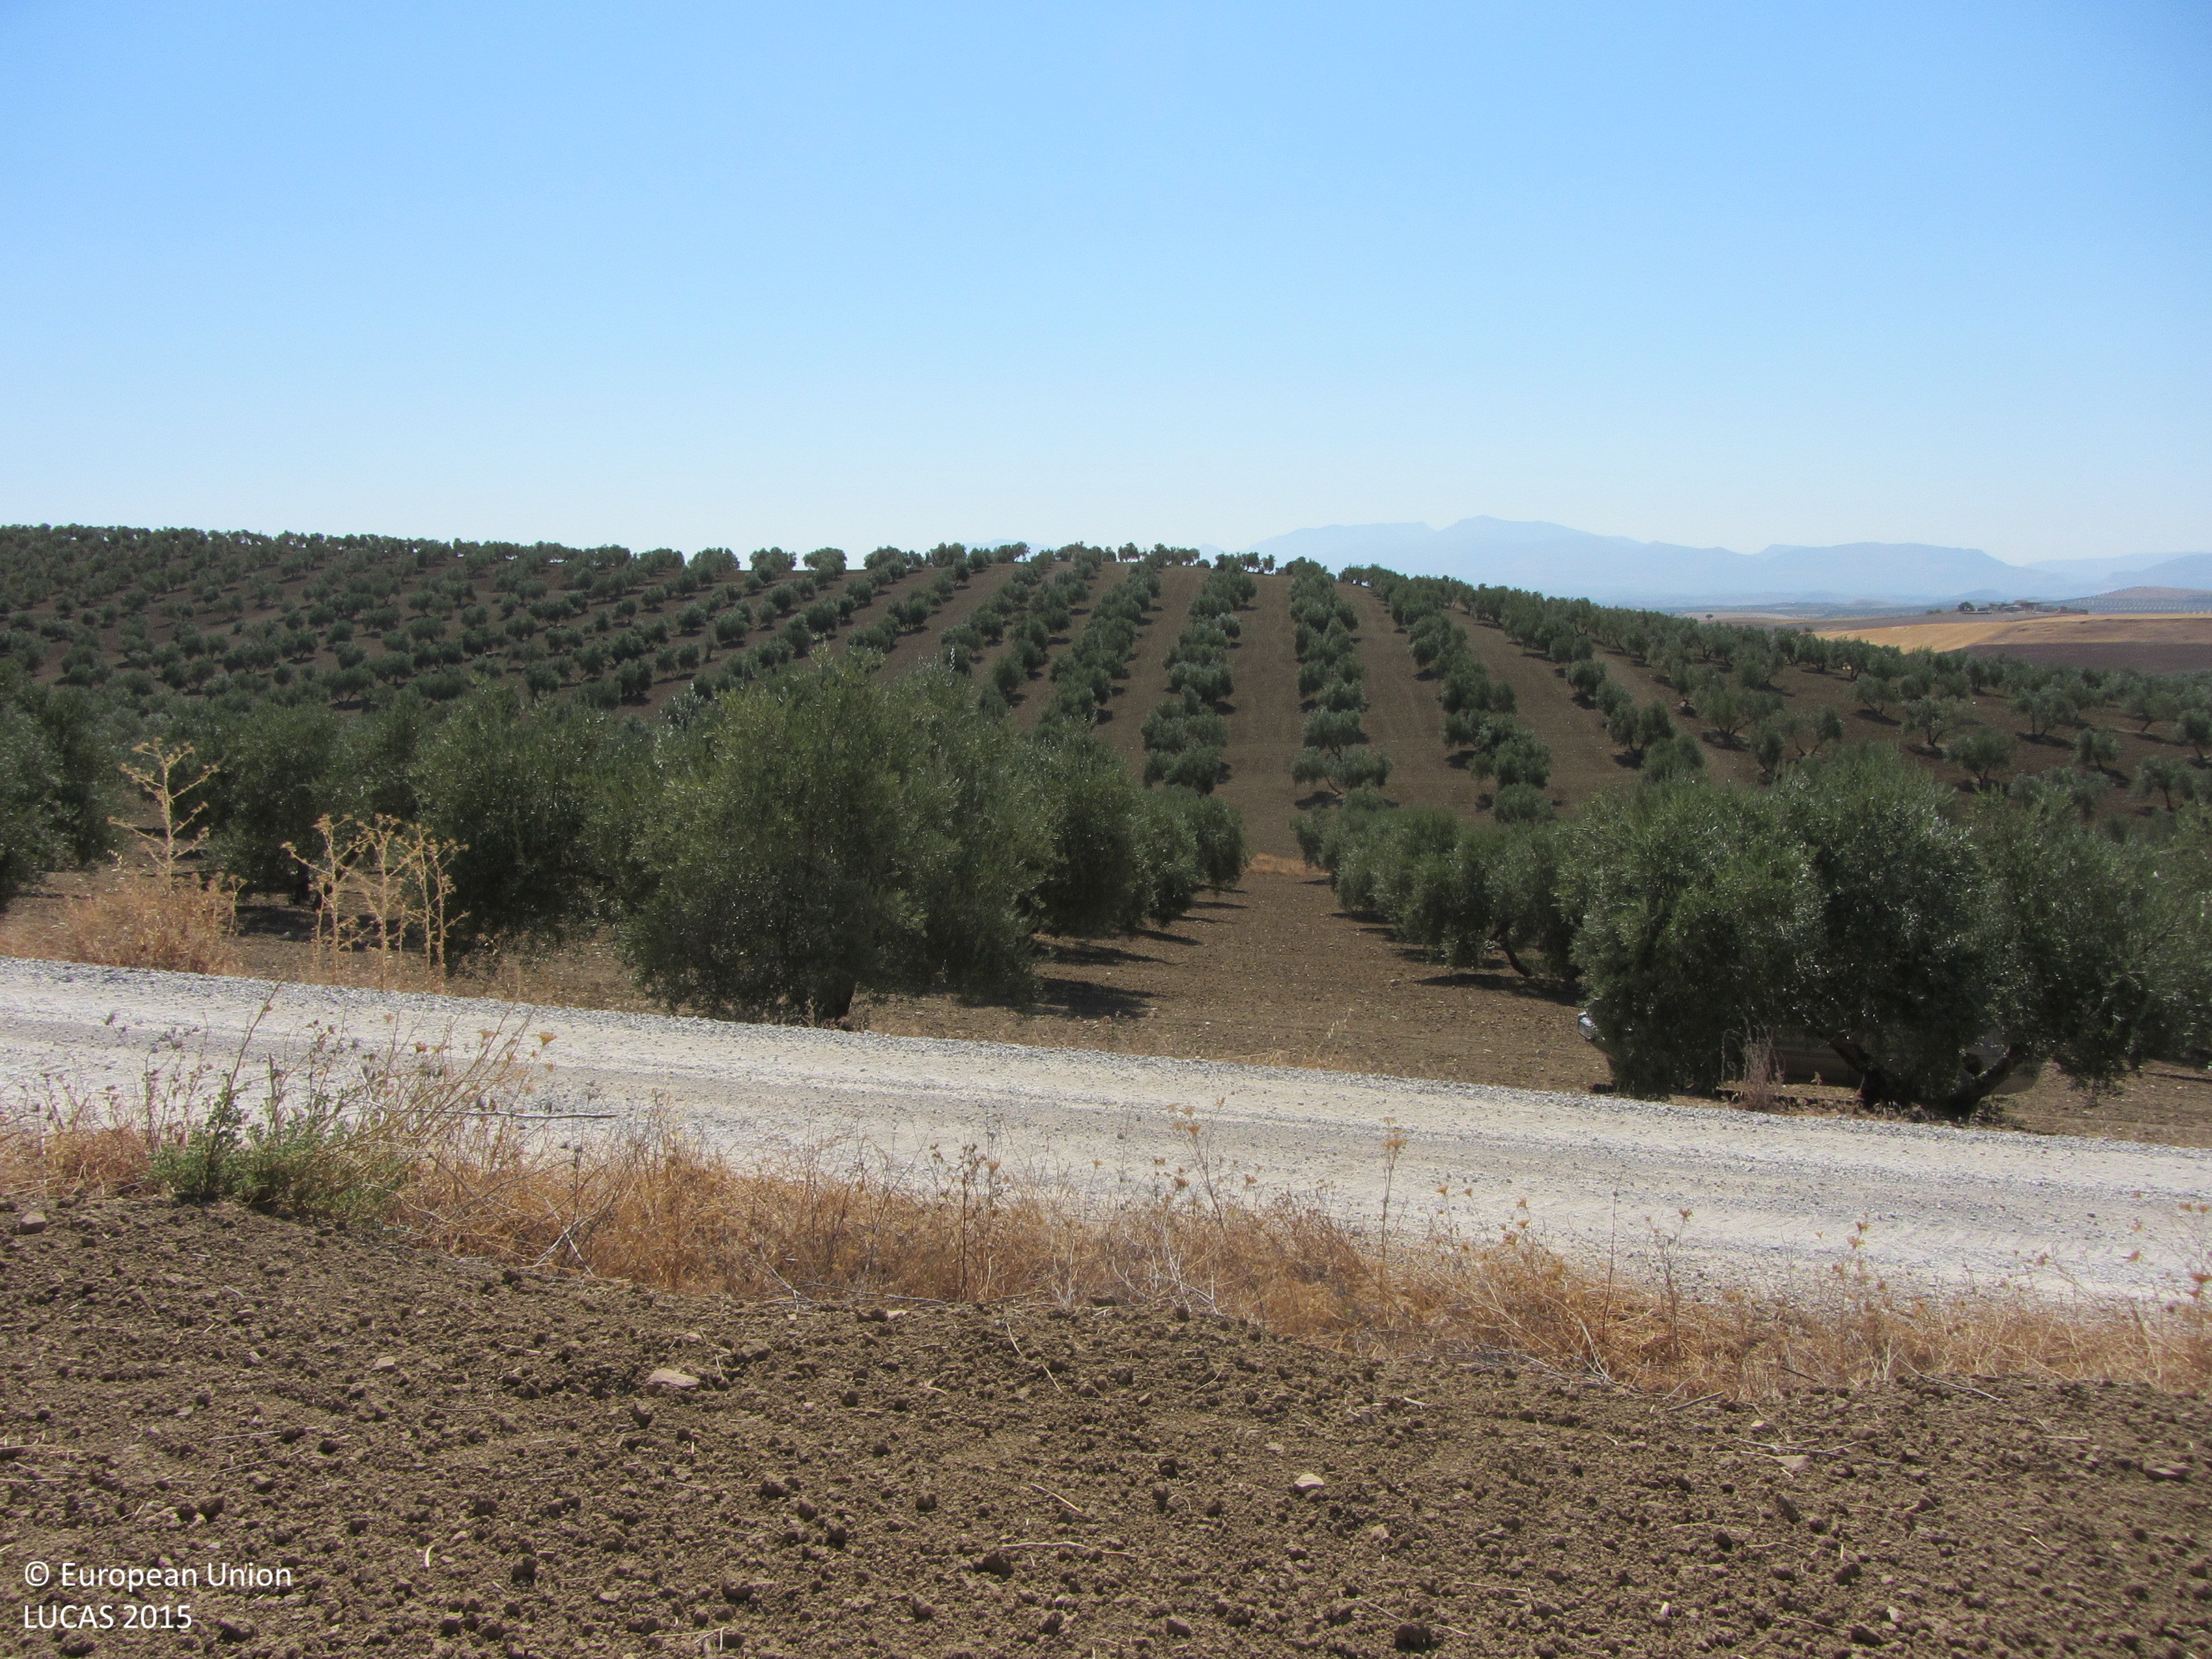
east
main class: Cropland
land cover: Olive groves
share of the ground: 25 - 50 %
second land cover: Other bare soil
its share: > 75 %
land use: Agriculture (excluding fallow land and kitchen gardens)
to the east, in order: Olive groves; Other bare soil; Ditches and canals; Grass margins; Tracks; Grass margins; Olive groves; Grass margins; Other structural elements; Grass margins; Olive groves
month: July
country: ES
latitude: 37.8838
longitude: -3.8632
